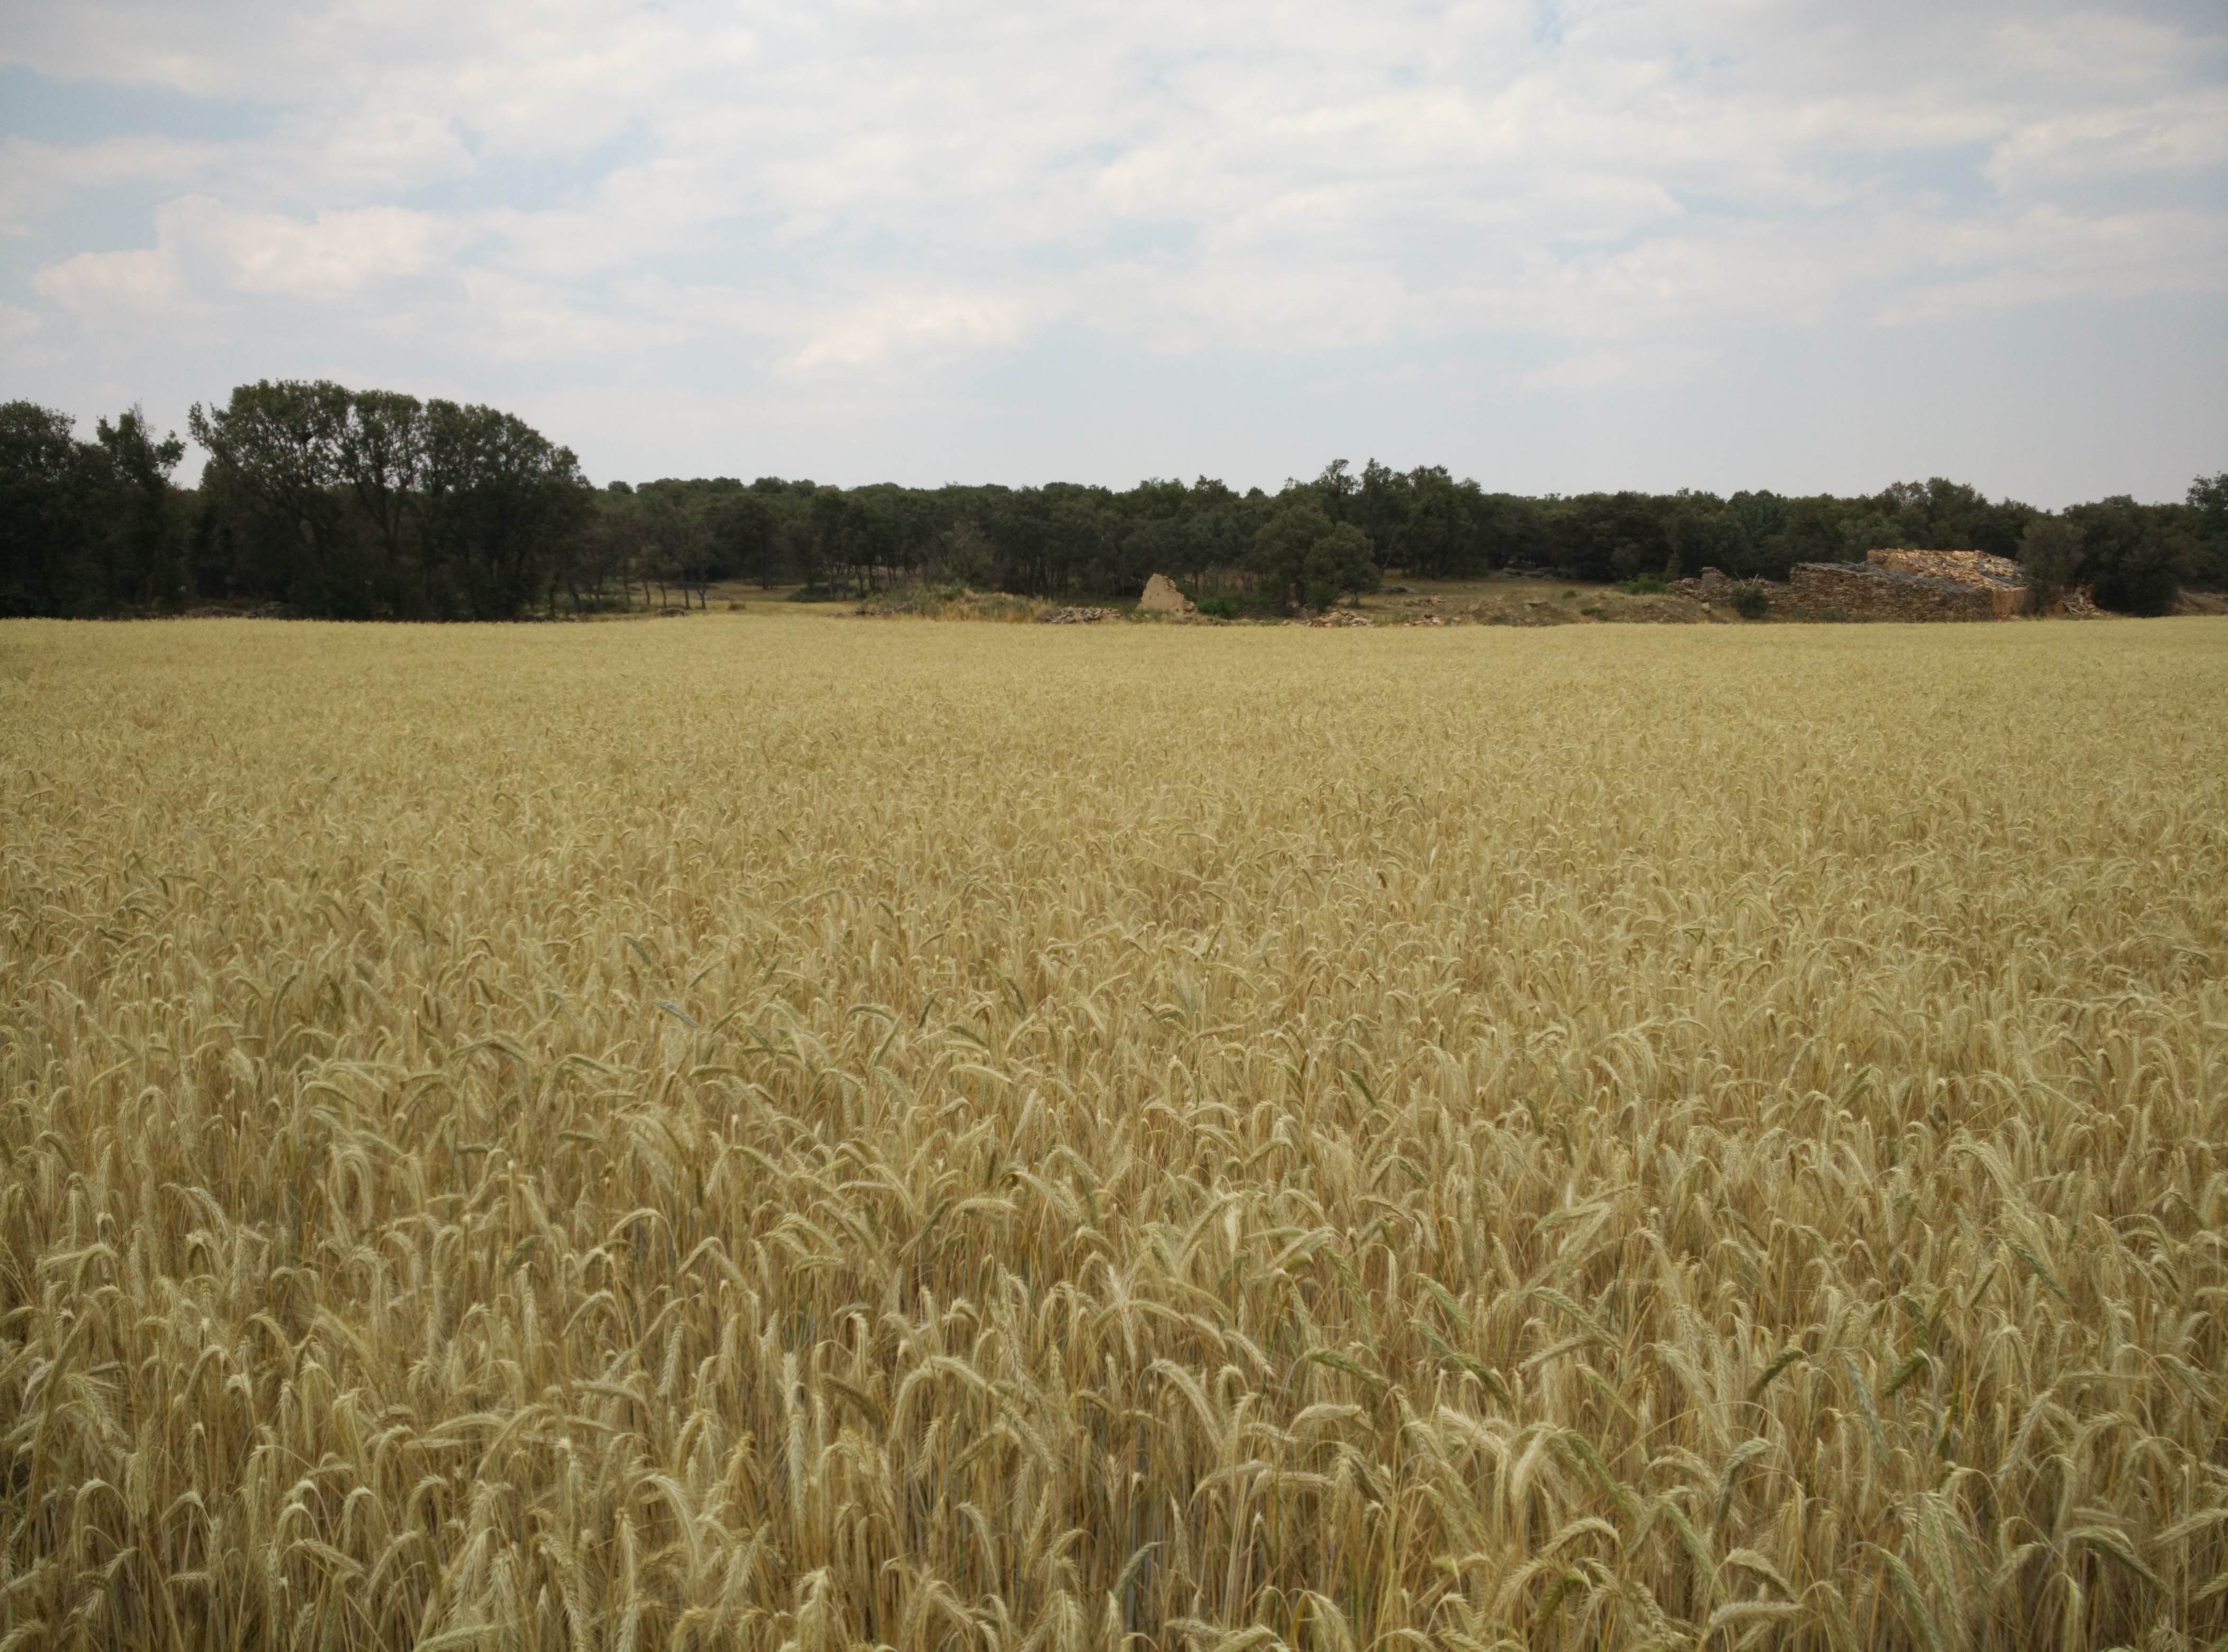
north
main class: Cropland
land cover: Barley
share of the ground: > 75 %
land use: Agriculture (excluding fallow land and kitchen gardens)
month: June
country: ES
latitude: 40.8997
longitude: -1.8335
